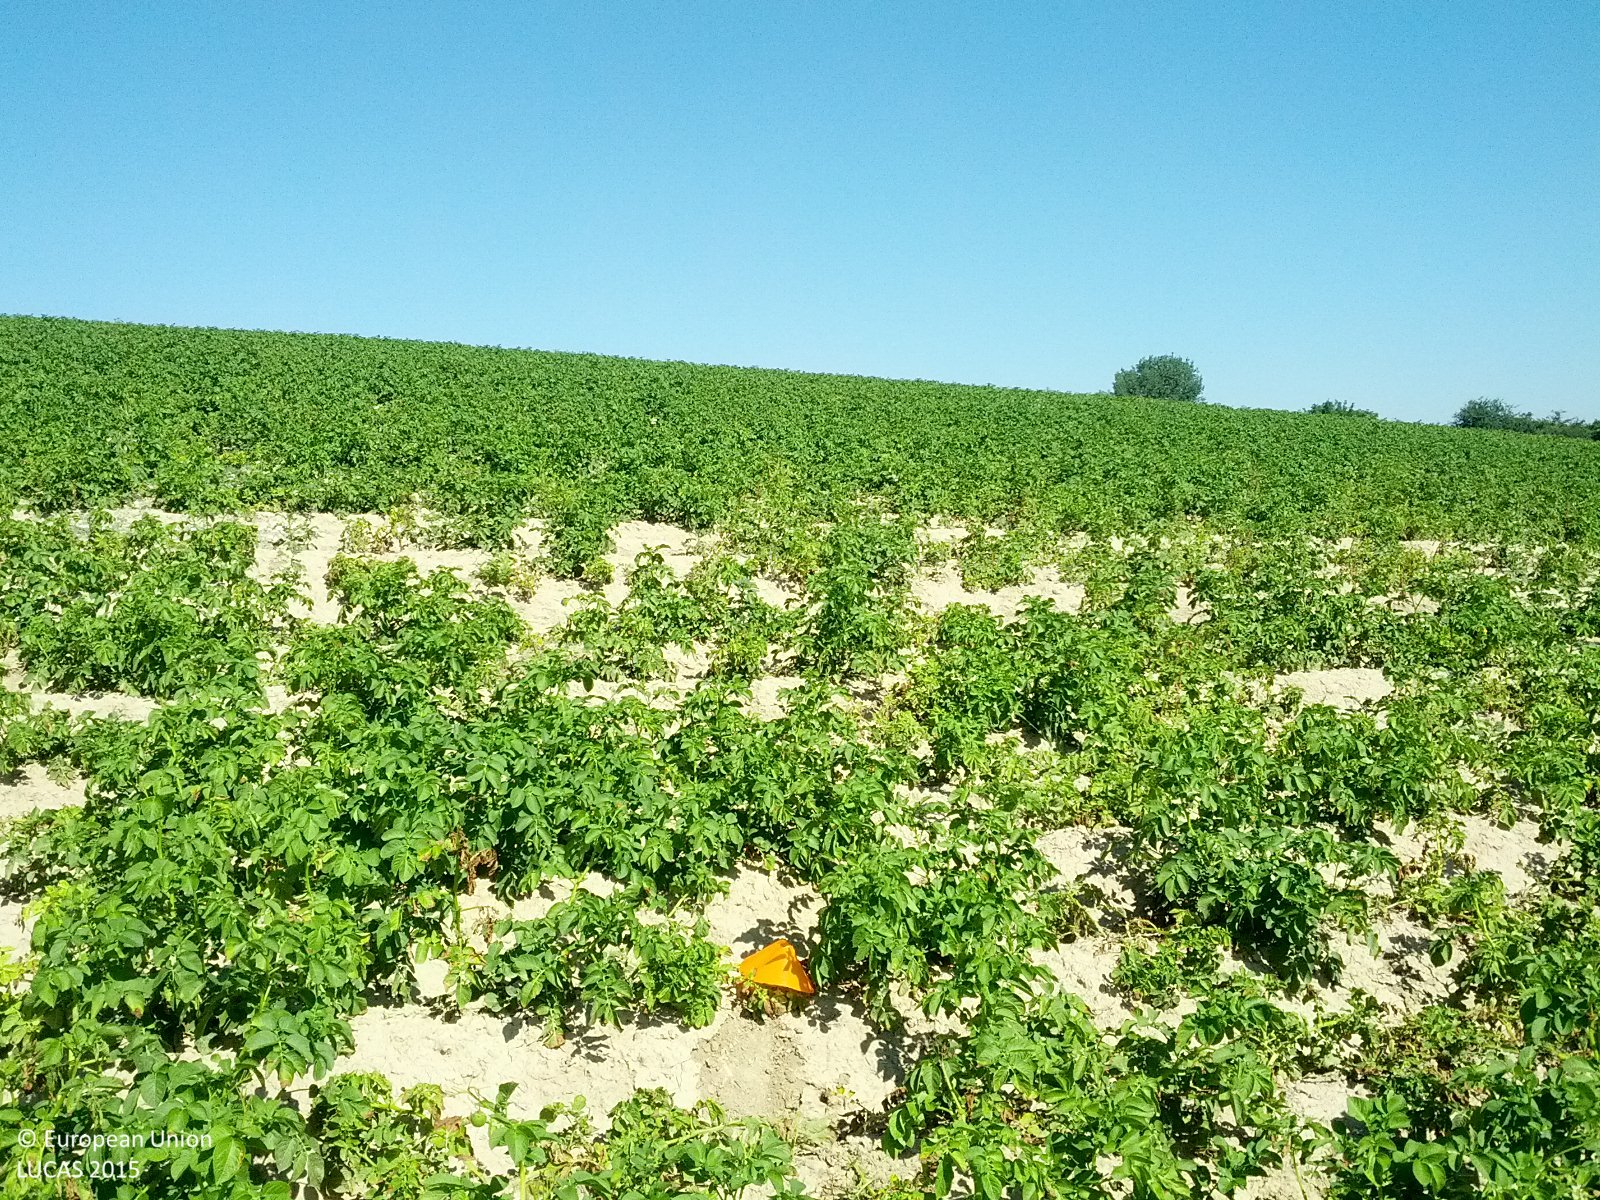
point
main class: Cropland
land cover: Potatoes
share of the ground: > 75 %
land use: Agriculture (excluding fallow land and kitchen gardens)
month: July
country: AT
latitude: 48.4679
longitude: 16.1315
